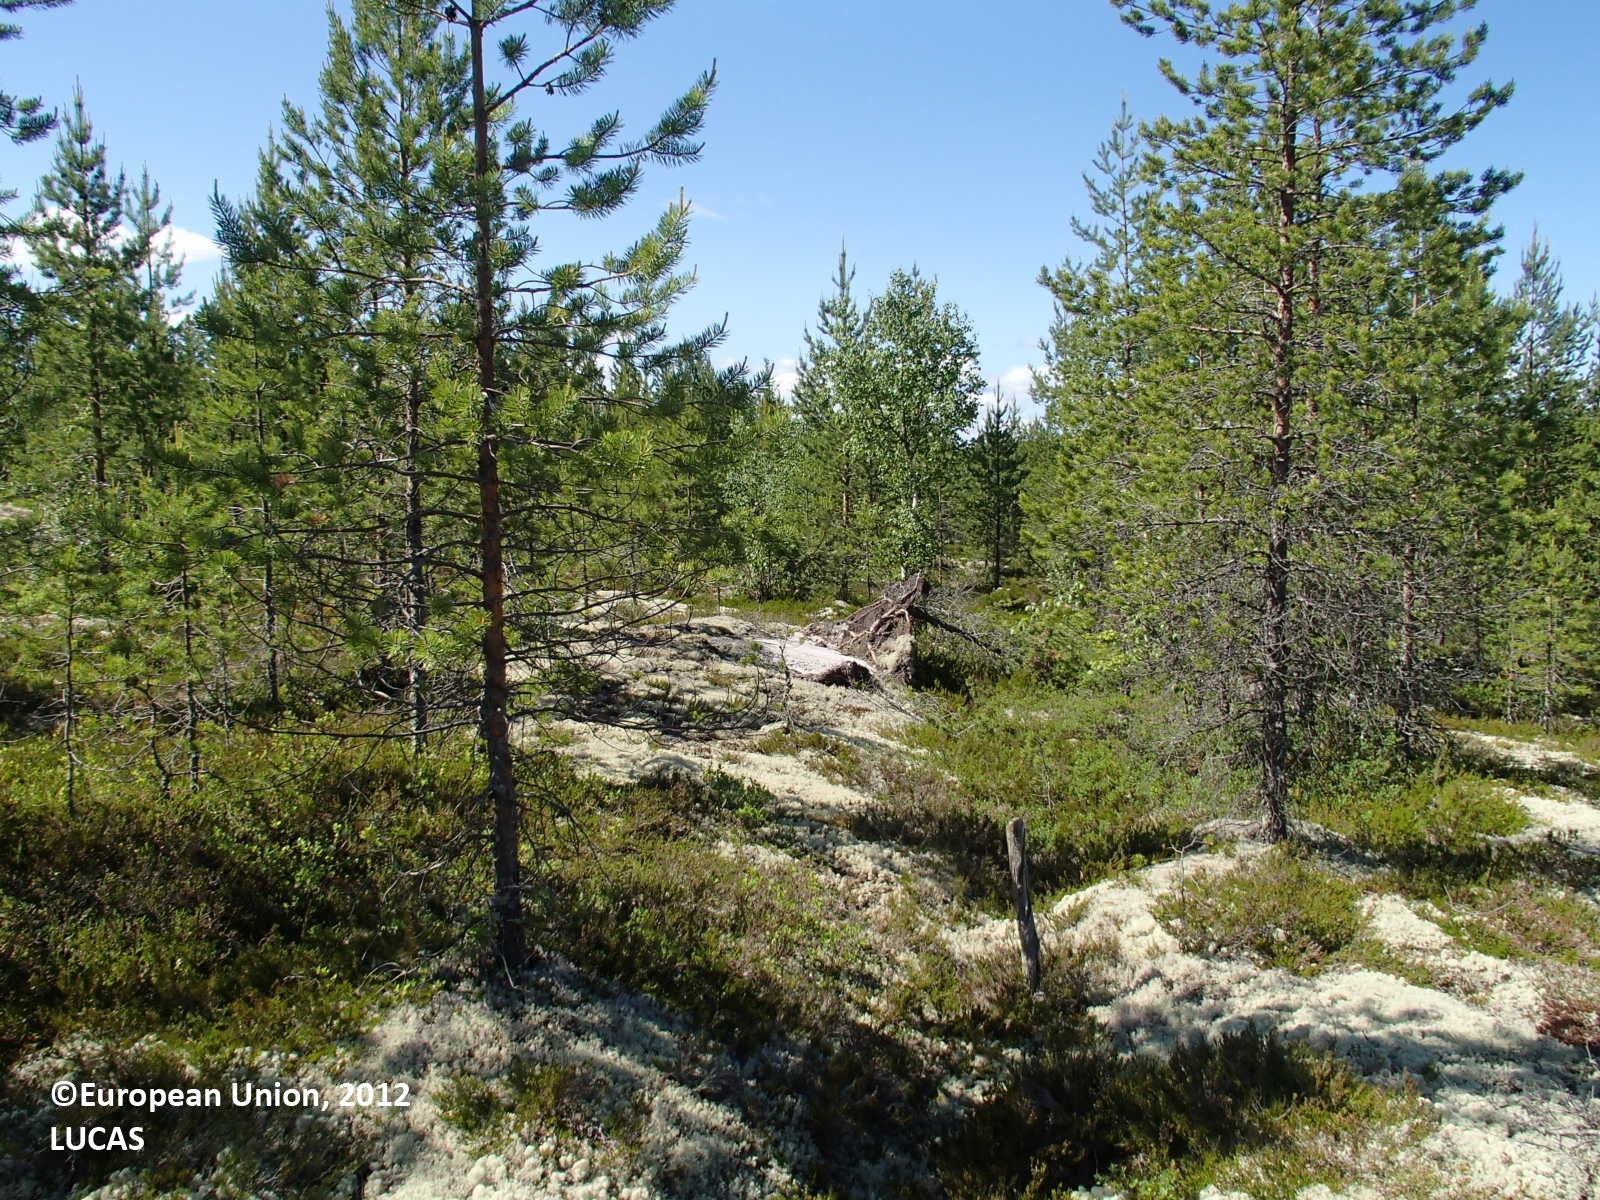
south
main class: Woodland
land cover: Pine dominated coniferous woodland
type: boreal forest
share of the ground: 25 - 50 %
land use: Forestry
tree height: < 5 m
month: June
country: FI
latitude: 64.2077
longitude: 27.3847
